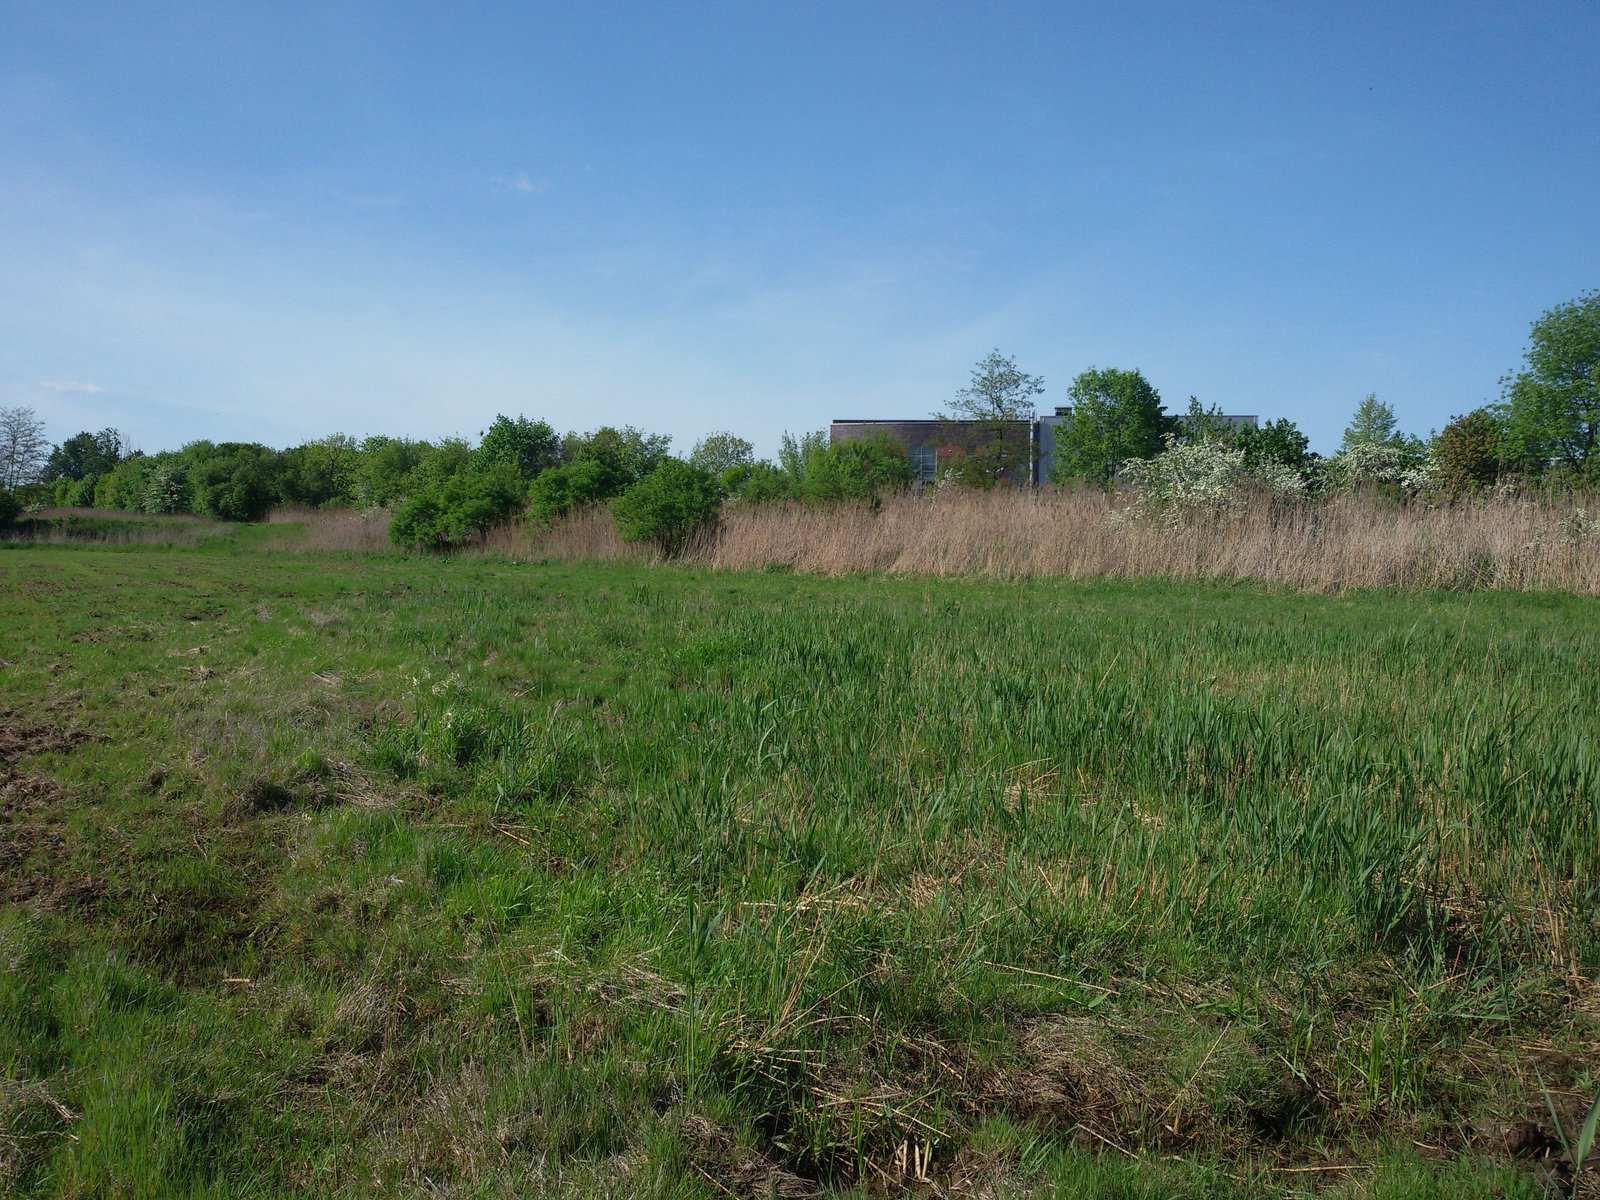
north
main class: Cropland
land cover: Temporary grasslands
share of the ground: > 75 %
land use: Agriculture (excluding fallow land and kitchen gardens)
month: May
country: PL
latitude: 50.3267
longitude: 18.6308
